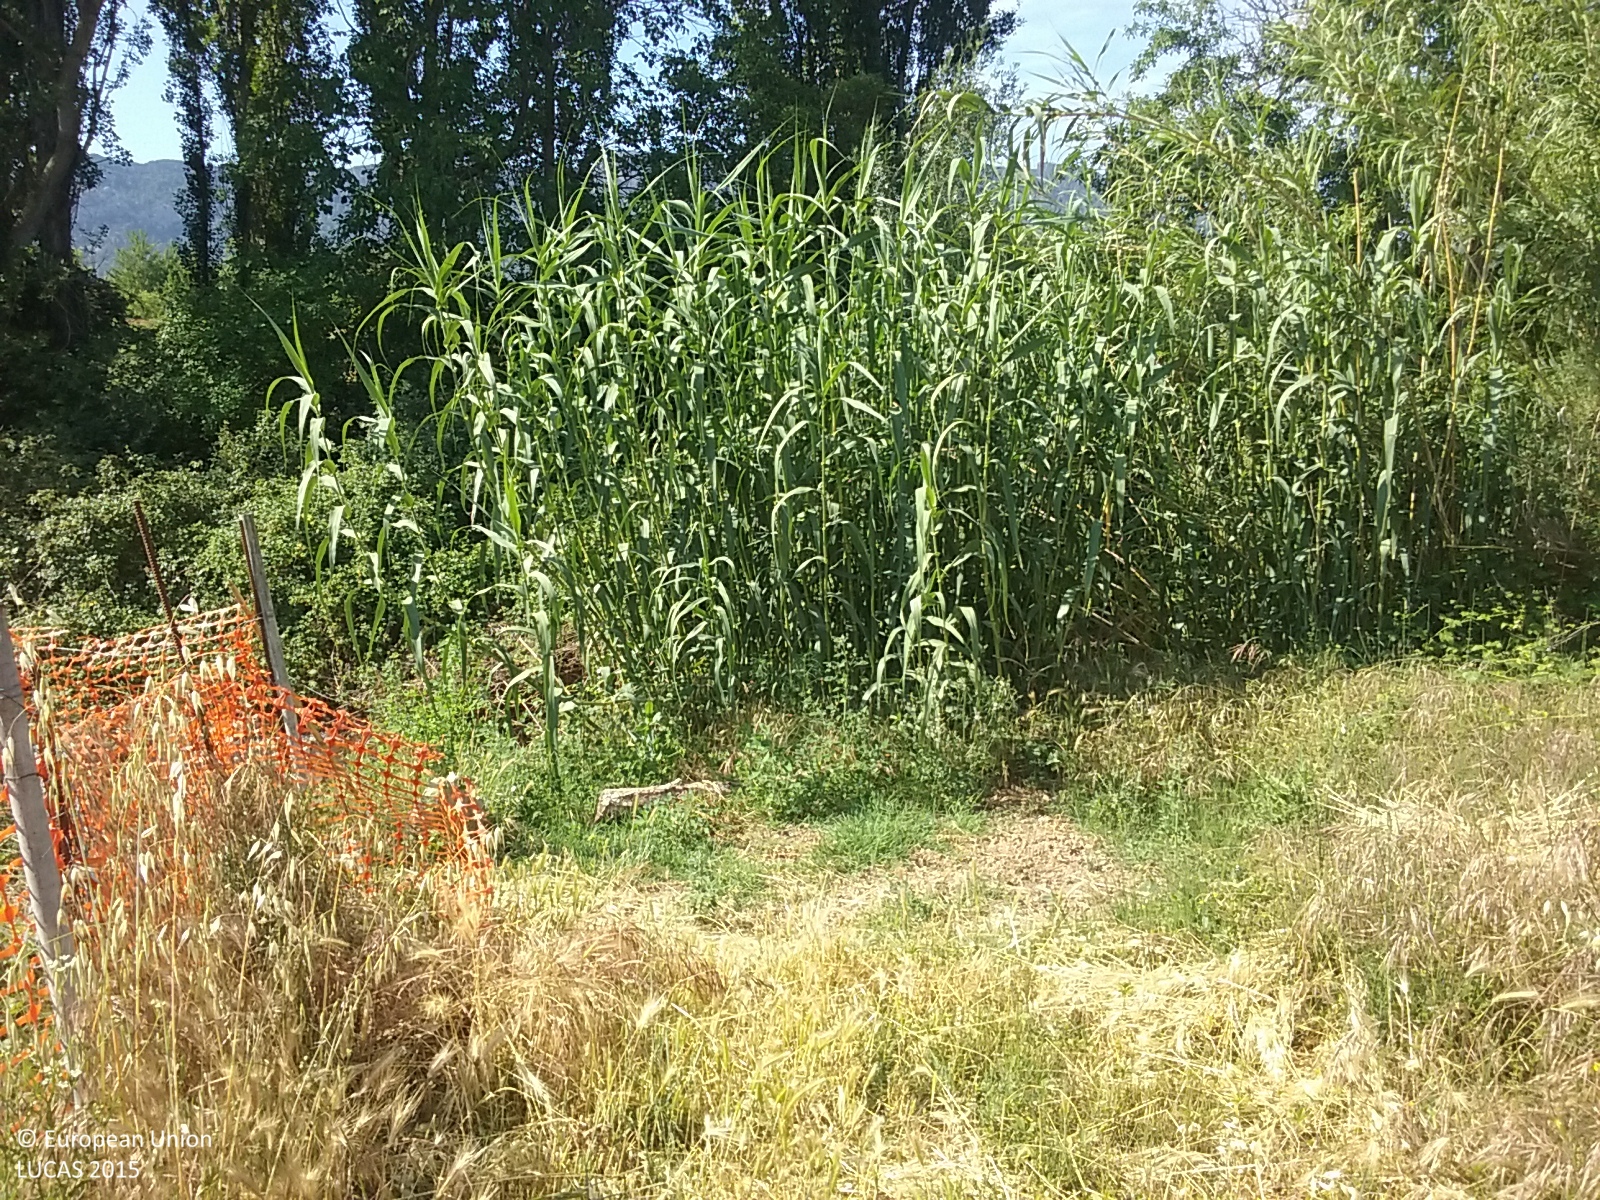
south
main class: Grassland
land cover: Spontaneously vegetated surfaces
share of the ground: > 75 %
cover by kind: herbaceous plants 100 %
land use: Abandoned areas
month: June
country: ES
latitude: 40.8637
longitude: 0.1564
